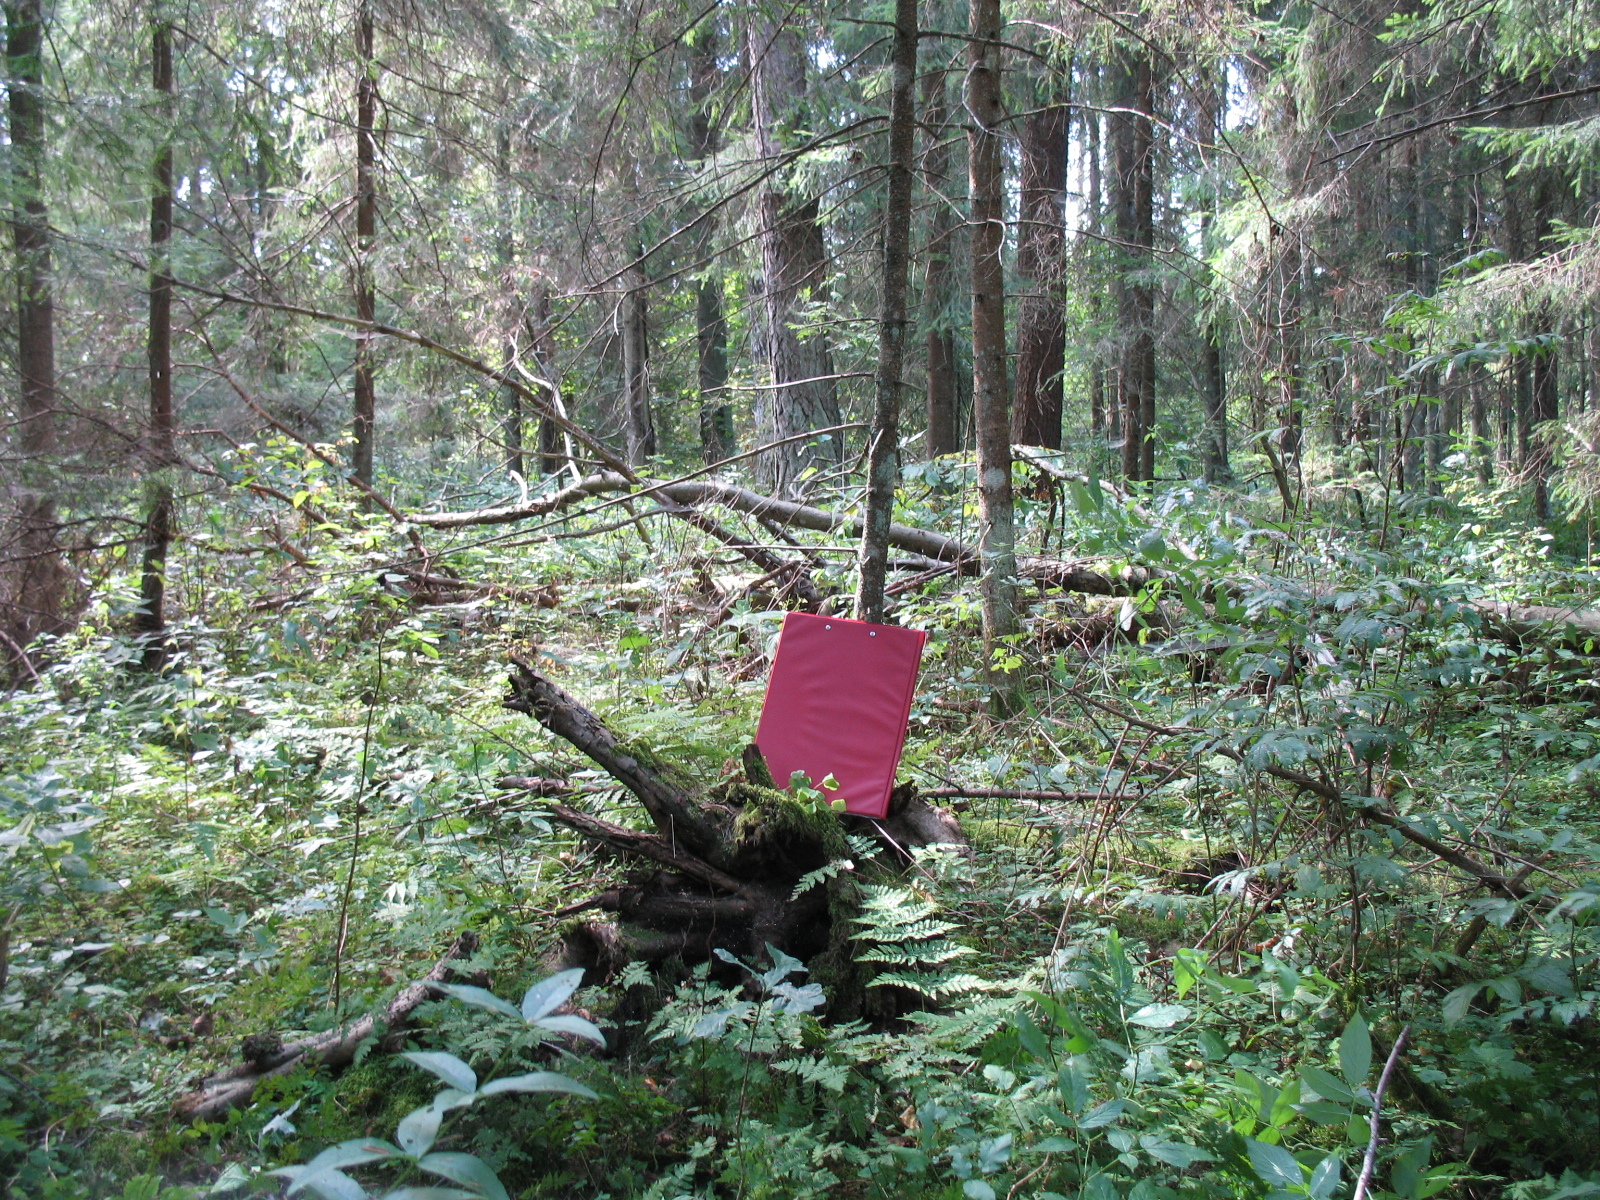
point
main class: Woodland
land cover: Other coniferous woodland
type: hemiboreal forest and nemoral coniferous forest and mixed broadleaved-coniferous forest
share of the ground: > 75 %
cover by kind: coniferous forest trees 75 %, broadleaved forest trees 10 %, herbaceous plants 10 %, shrubs 5 %
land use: Forestry
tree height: > 5 m
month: August
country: LV
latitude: 56.3478
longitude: 25.5752
